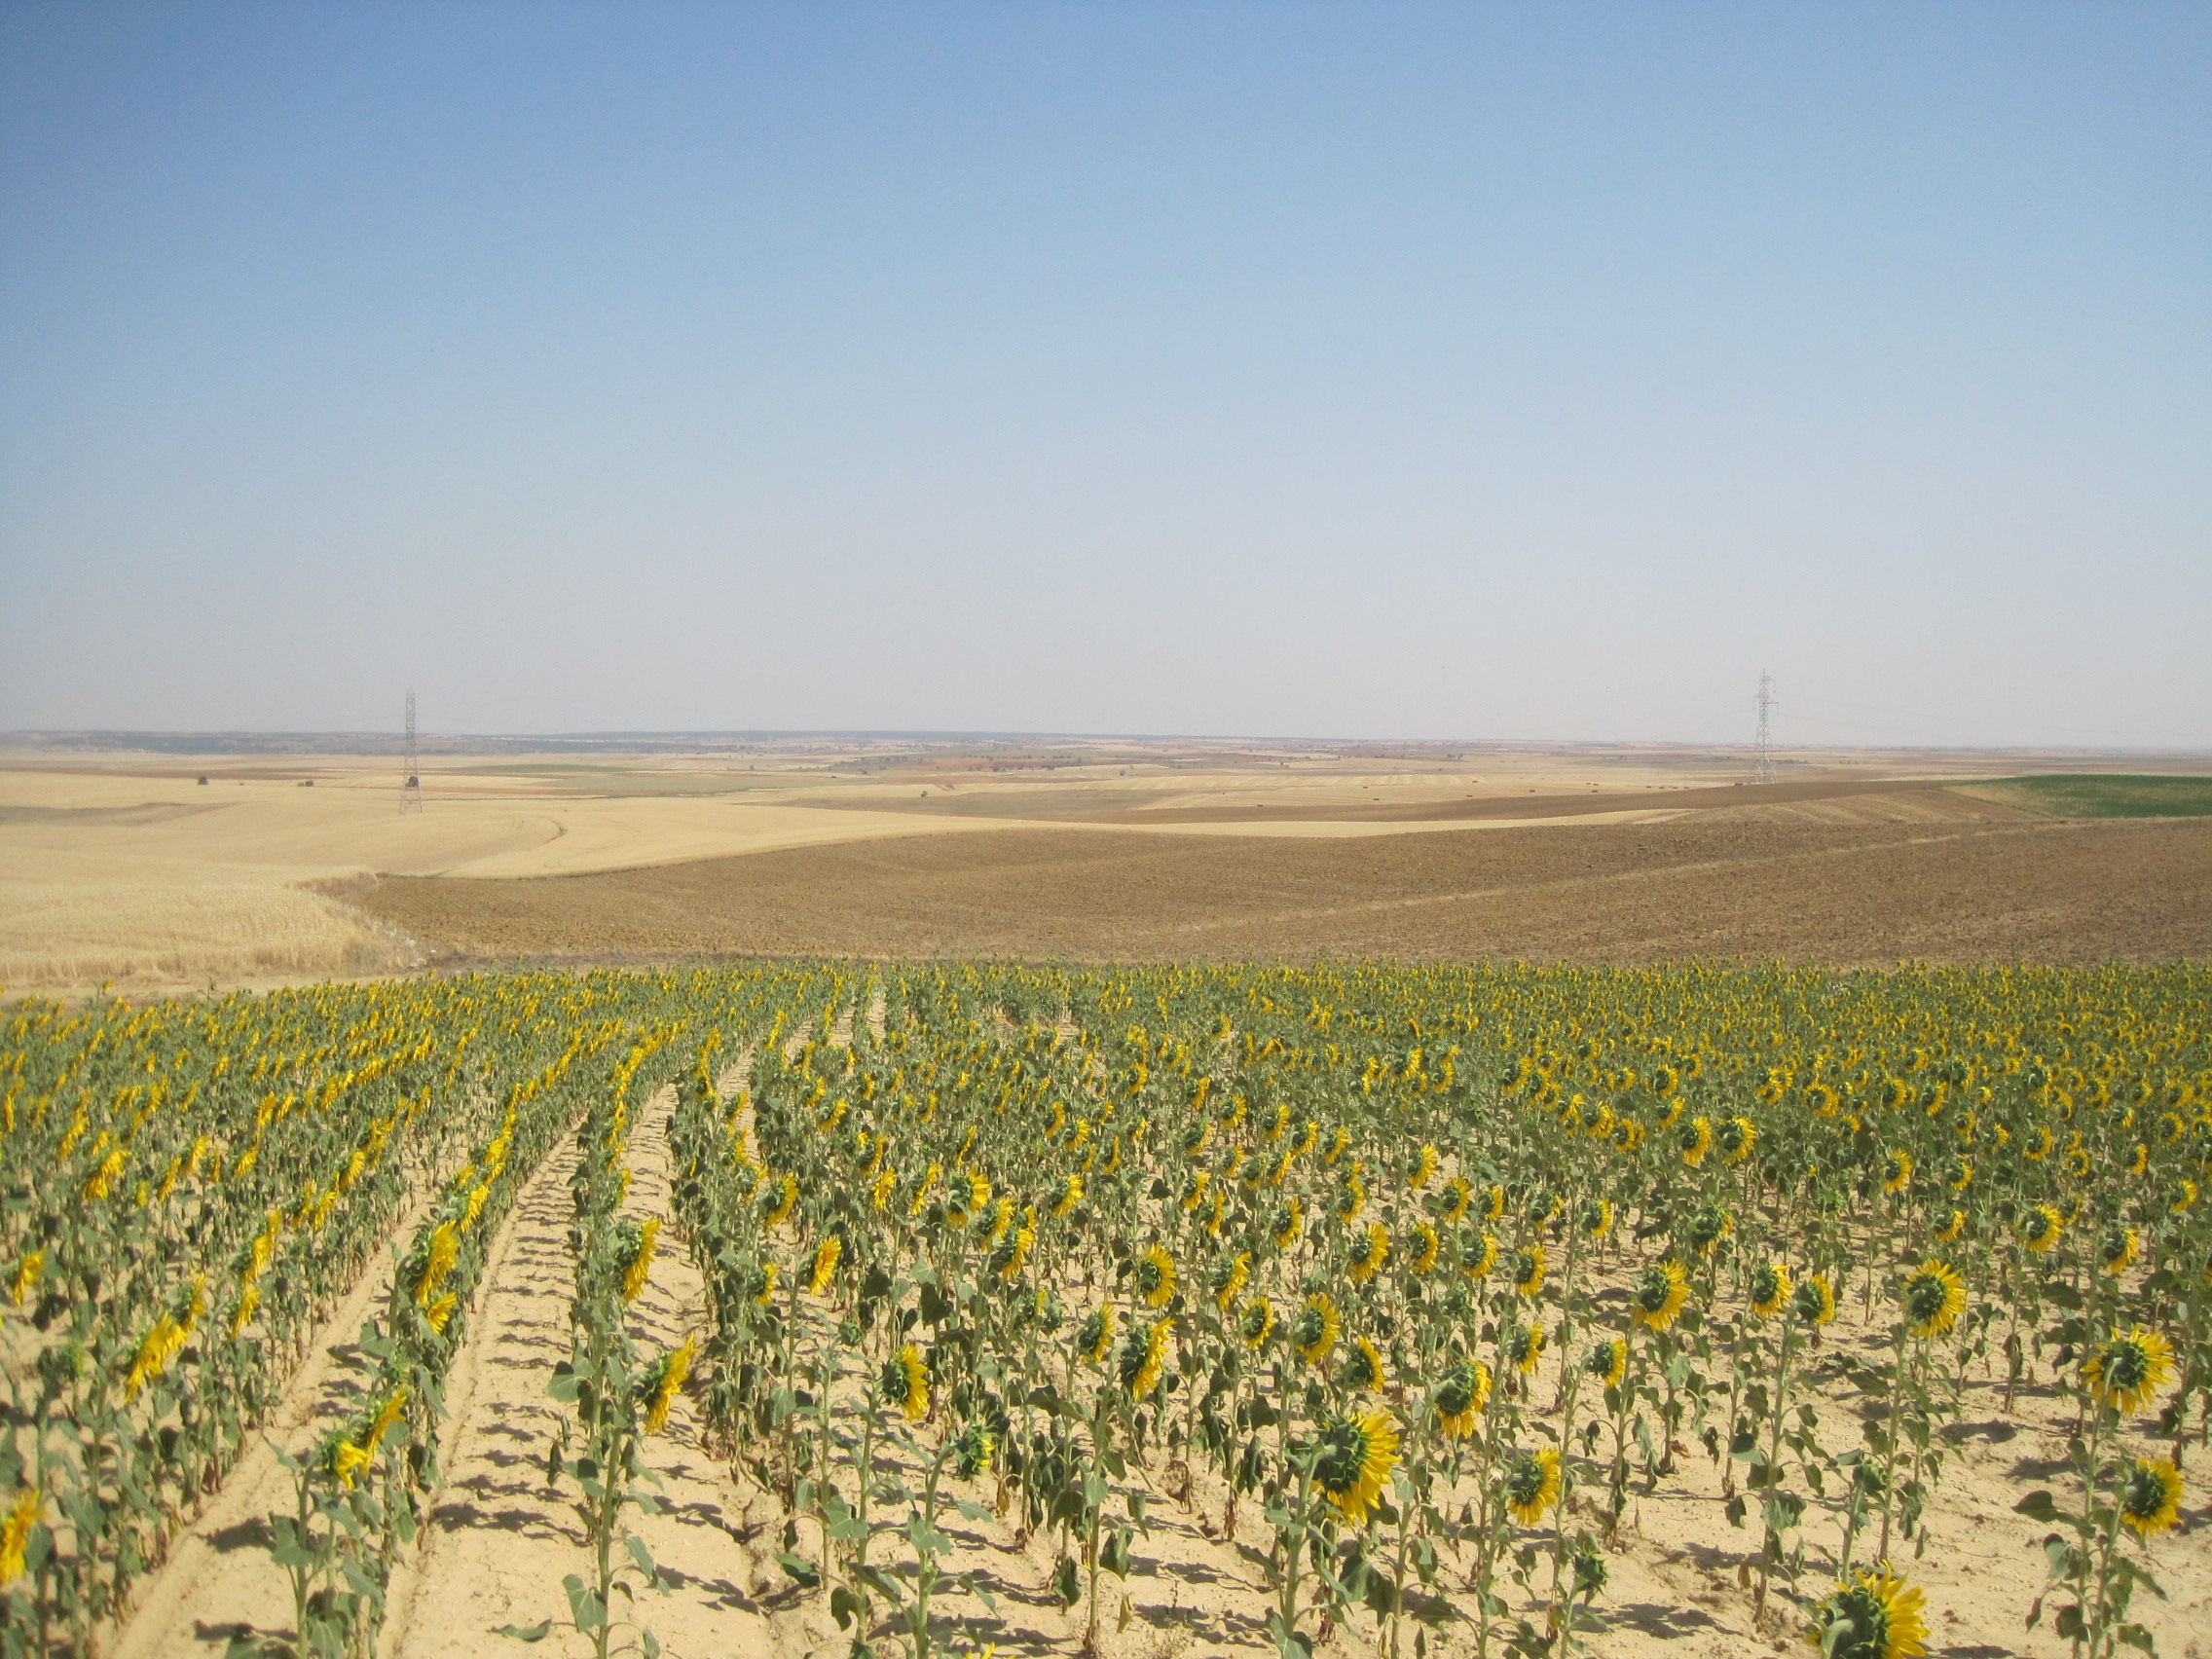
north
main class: Cropland
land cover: Sunflower
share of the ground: > 75 %
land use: Agriculture (excluding fallow land and kitchen gardens)
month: July
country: ES
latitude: 41.6493
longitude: -5.4149
